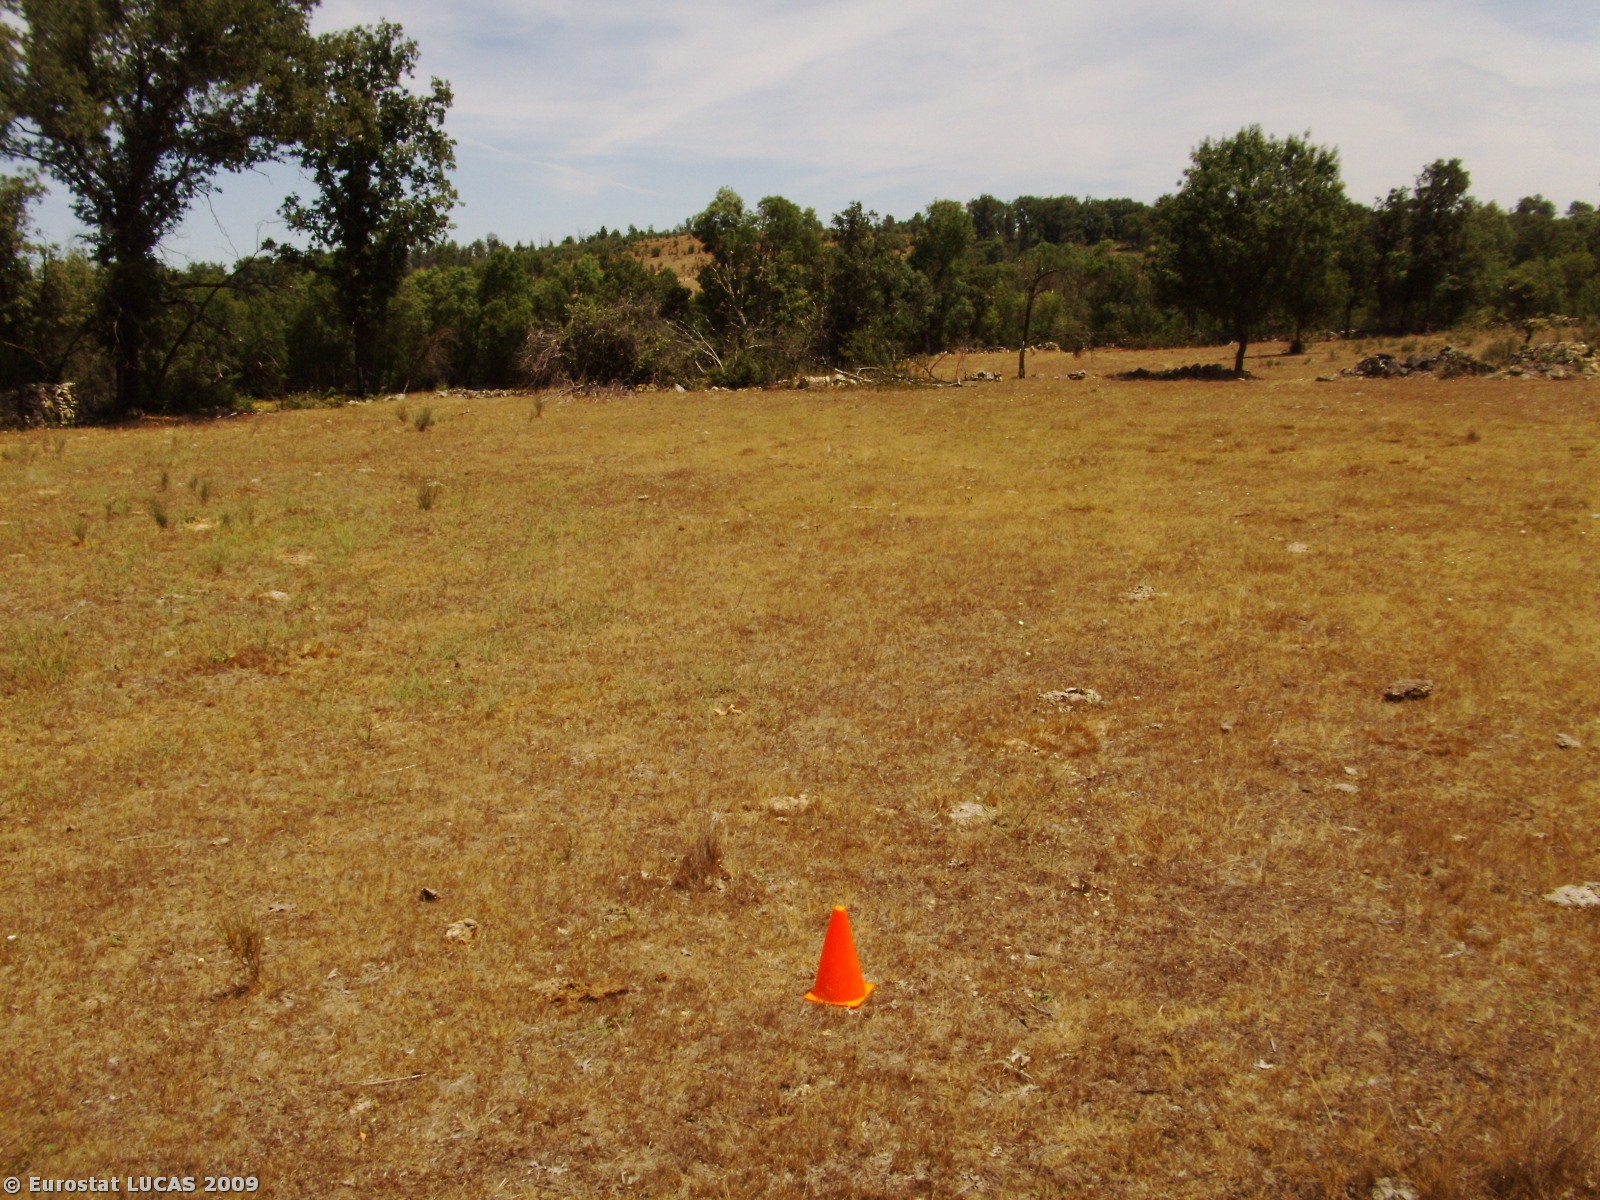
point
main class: Grassland
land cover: Spontaneously vegetated surfaces
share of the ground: > 75 %
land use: Fallow land
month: July
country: PT
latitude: 40.4149
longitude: -6.9848
